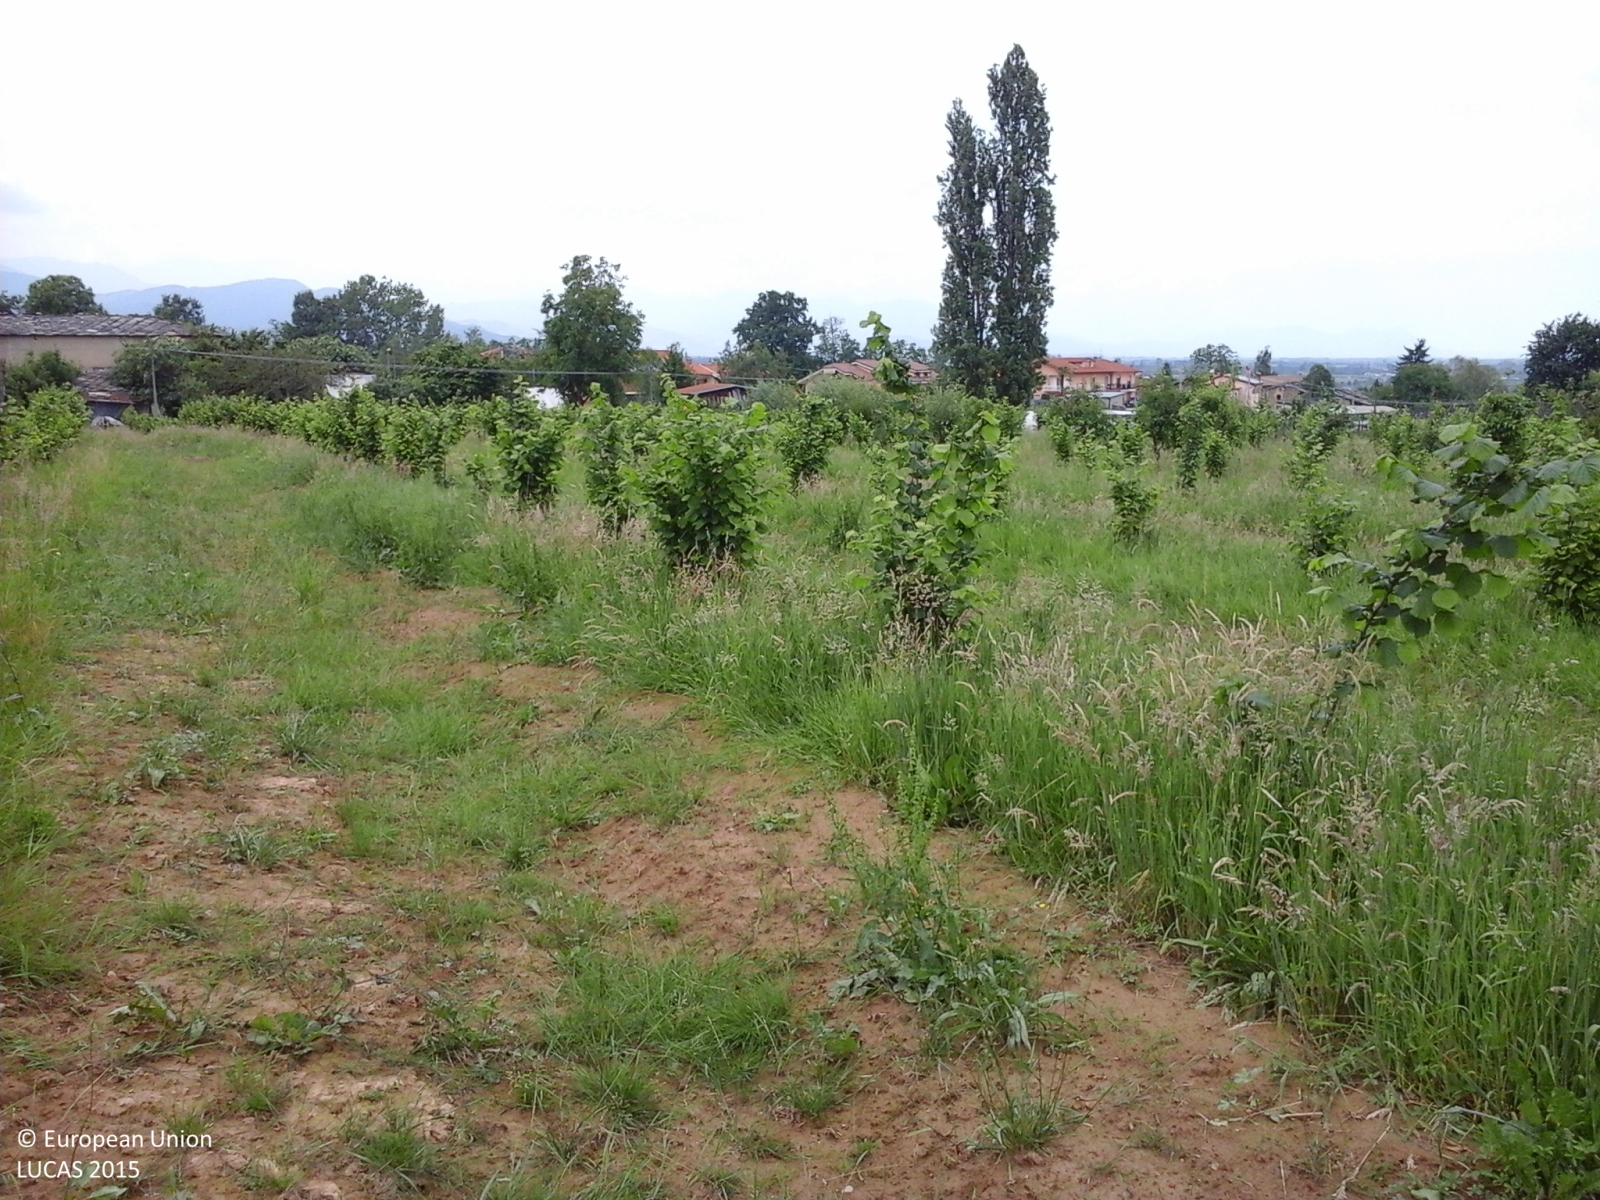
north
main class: Cropland
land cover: Nuts trees
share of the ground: 50 - 75 %
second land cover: Grassland without tree/shrub cover
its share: > 75 %
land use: Agriculture (excluding fallow land and kitchen gardens)
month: May
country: IT
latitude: 44.7489
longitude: 7.3146
